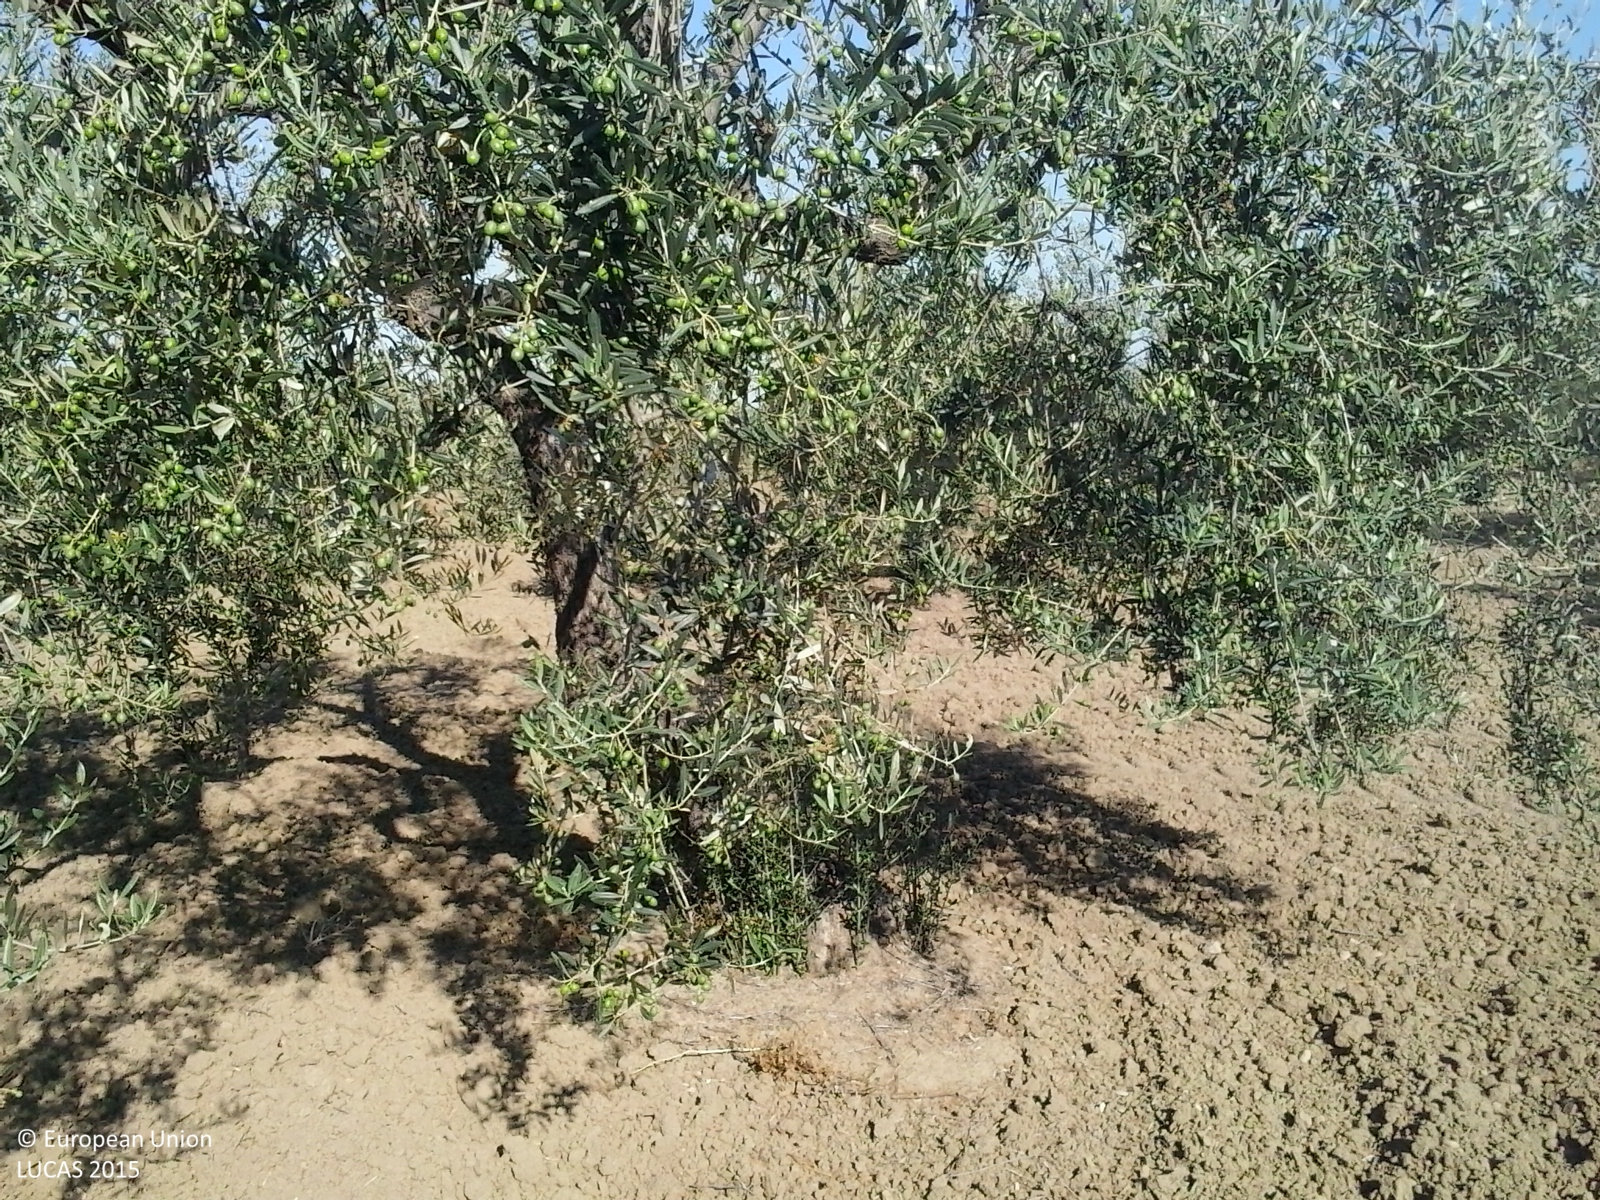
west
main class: Cropland
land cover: Olive groves
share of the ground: 25 - 50 %
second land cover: Other bare soil
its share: > 75 %
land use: Agriculture (excluding fallow land and kitchen gardens)
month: June
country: ES
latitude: 37.4404
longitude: -6.1791
